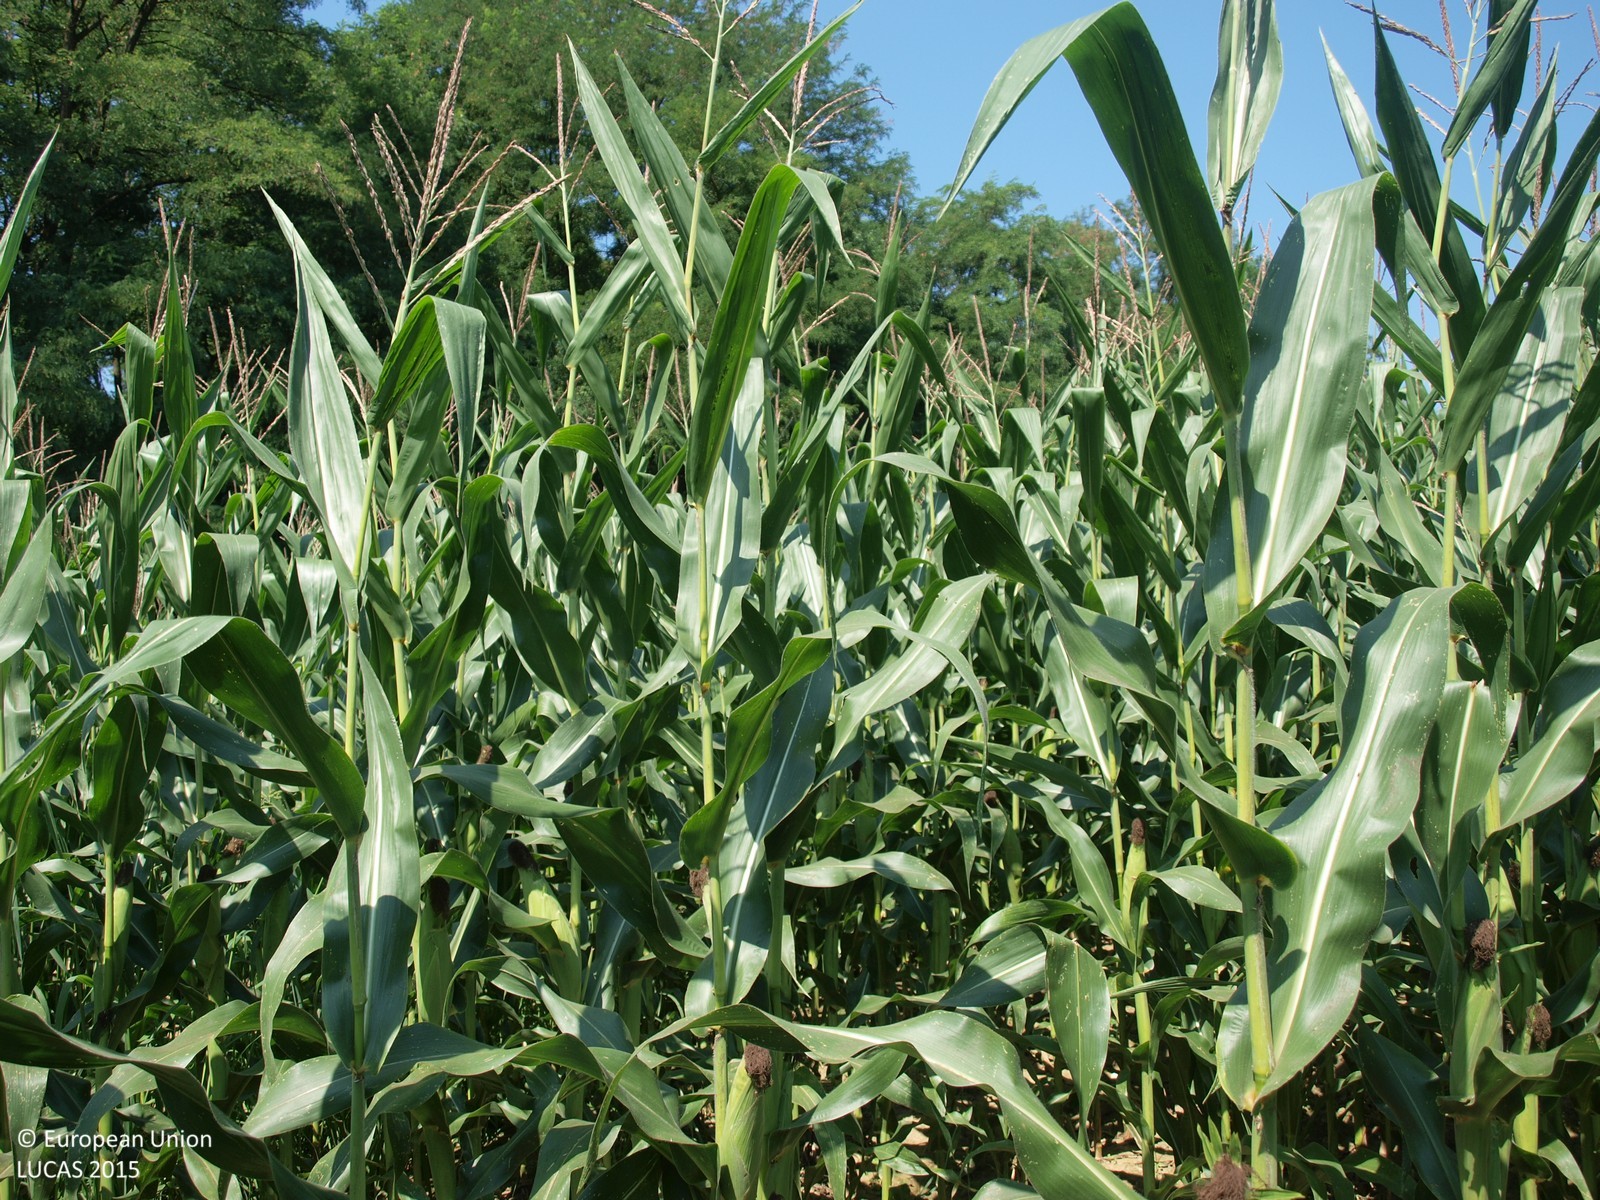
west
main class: Cropland
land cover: Maize
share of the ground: > 75 %
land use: Agriculture (excluding fallow land and kitchen gardens)
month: August
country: HR
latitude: 45.8968
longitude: 16.5598
